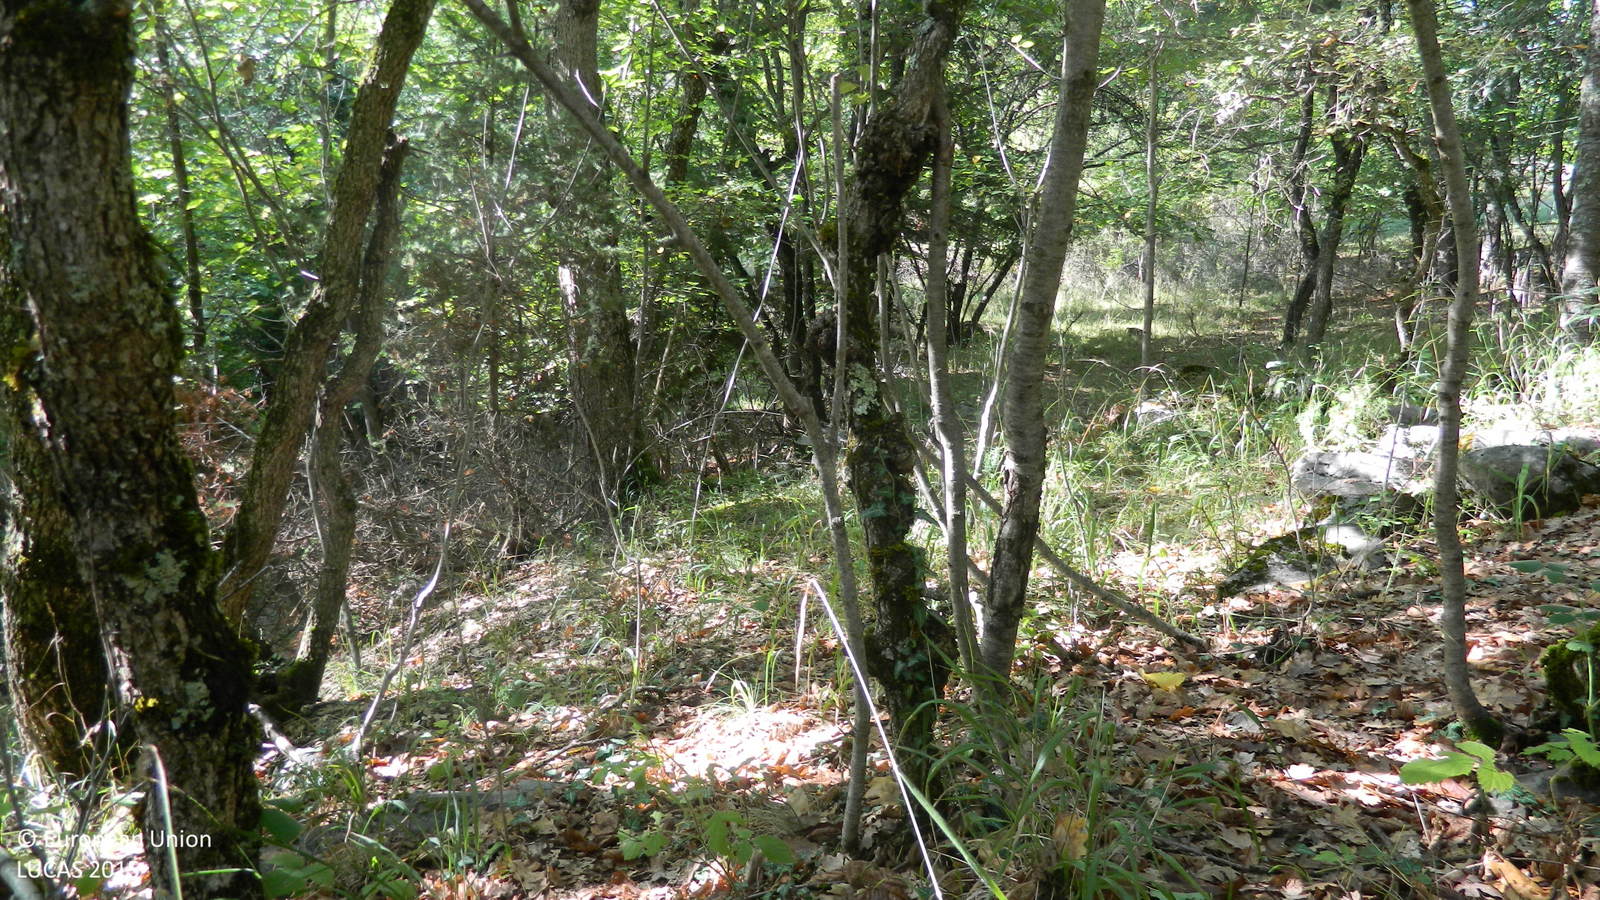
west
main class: Woodland
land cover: Broadleaved woodland
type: mesophytic deciduous forest
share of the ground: > 75 %
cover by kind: broadleaved forest trees 95 %, coniferous forest trees 5 %
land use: Forestry
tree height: > 5 m
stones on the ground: 25 - 50 %
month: September
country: BG
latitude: 41.5095
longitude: 24.0138
